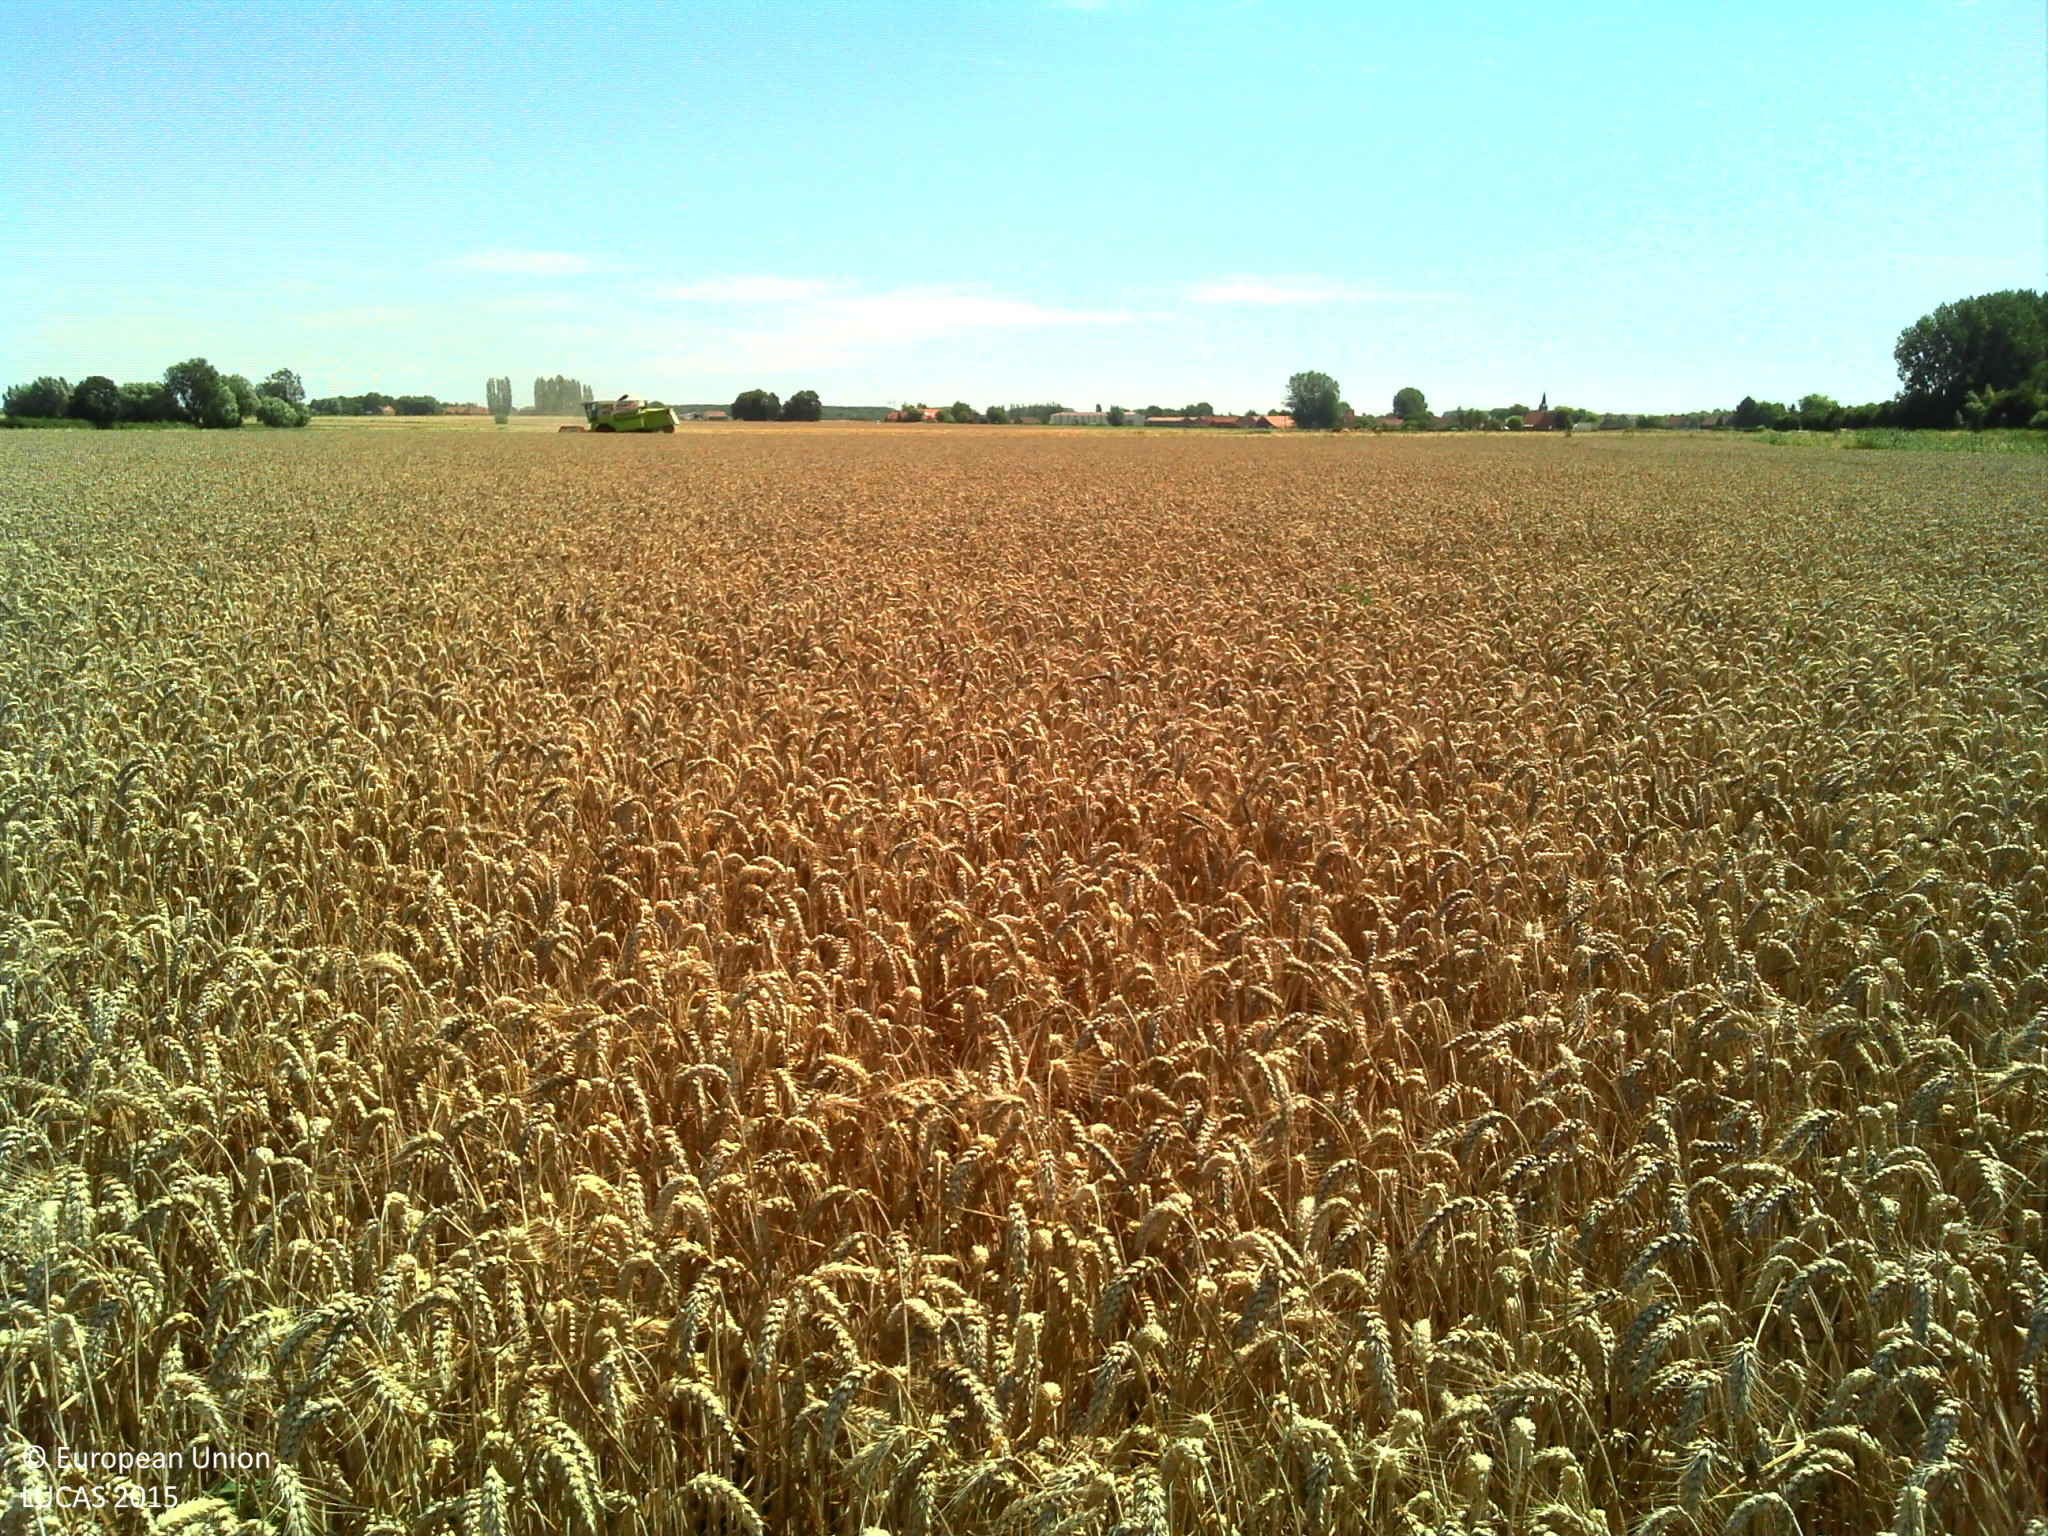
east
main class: Cropland
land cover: Common wheat
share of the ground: > 75 %
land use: Agriculture (excluding fallow land and kitchen gardens)
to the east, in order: Common wheat; Grass margins; Tracks; Grass margins; Ditches and canals; Grassland without tree/shrub cover; Common wheat
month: August
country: FR
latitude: 50.6560
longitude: 2.4476
